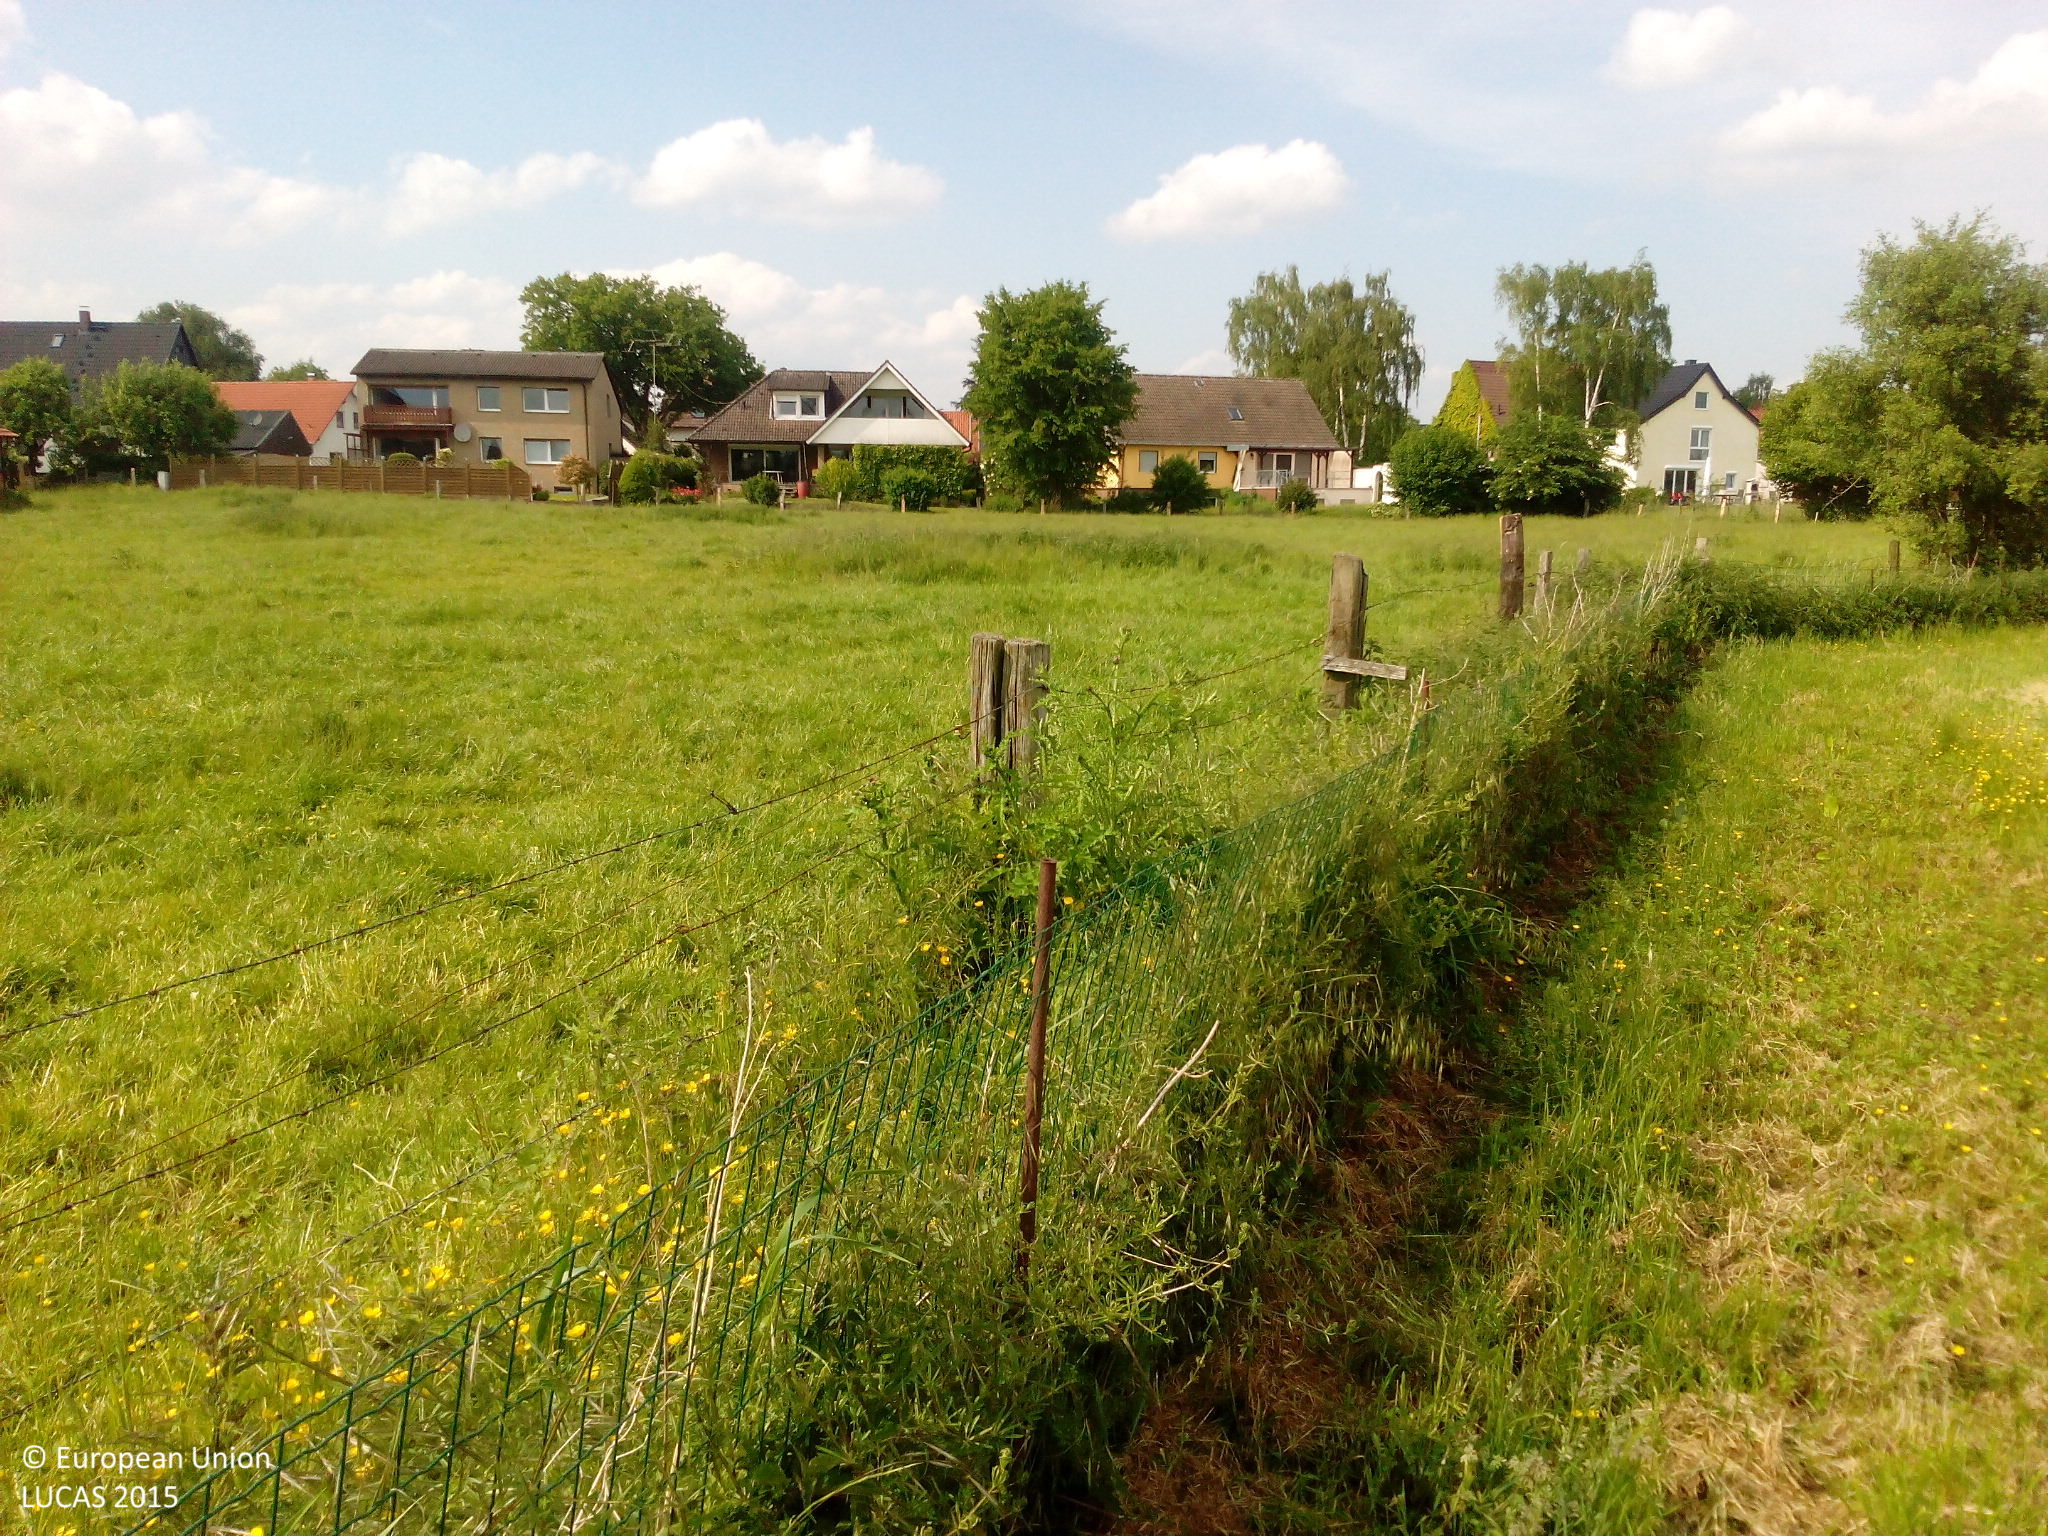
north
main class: Grassland
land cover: Grassland without tree/shrub cover
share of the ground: > 75 %
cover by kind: herbaceous plants 100 %
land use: Agriculture (excluding fallow land and kitchen gardens)
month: June
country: DE
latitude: 51.6408
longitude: 7.9629
